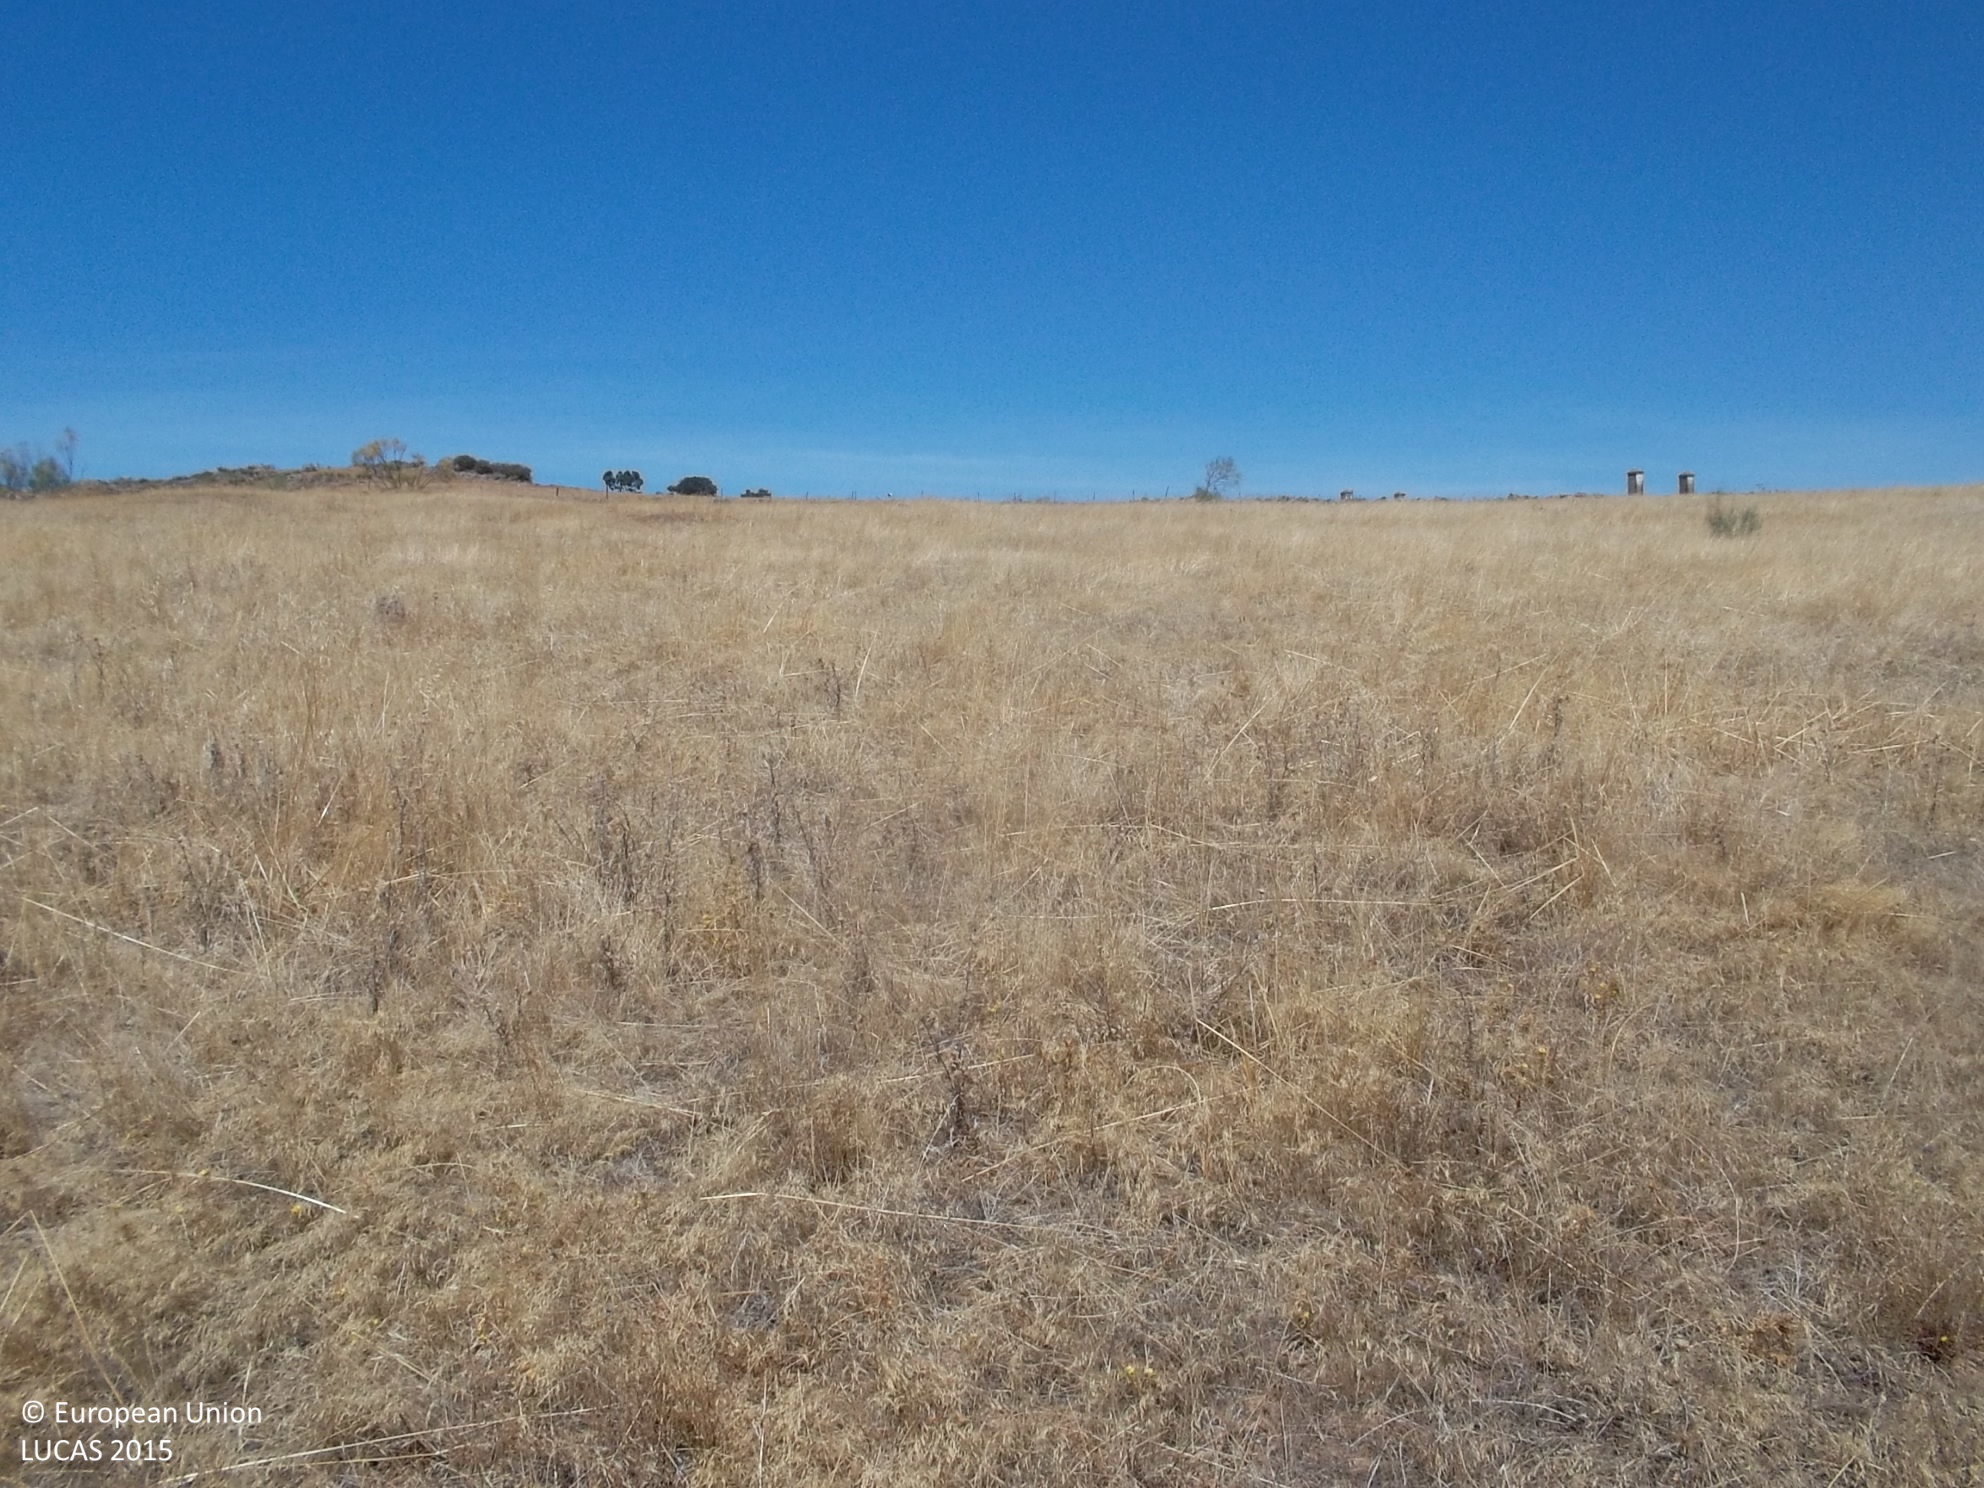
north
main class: Woodland
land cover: Broadleaved woodland
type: broadleaved evergreen forest
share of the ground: 25 - 50 %
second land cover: Grassland without tree/shrub cover
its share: > 75 %
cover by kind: herbaceous plants 70 %, broadleaved forest trees 30 %
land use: Forestry
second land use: Agriculture (excluding fallow land and kitchen gardens)
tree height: < 5 m
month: August
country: ES
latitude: 38.2368
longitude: -6.5819
